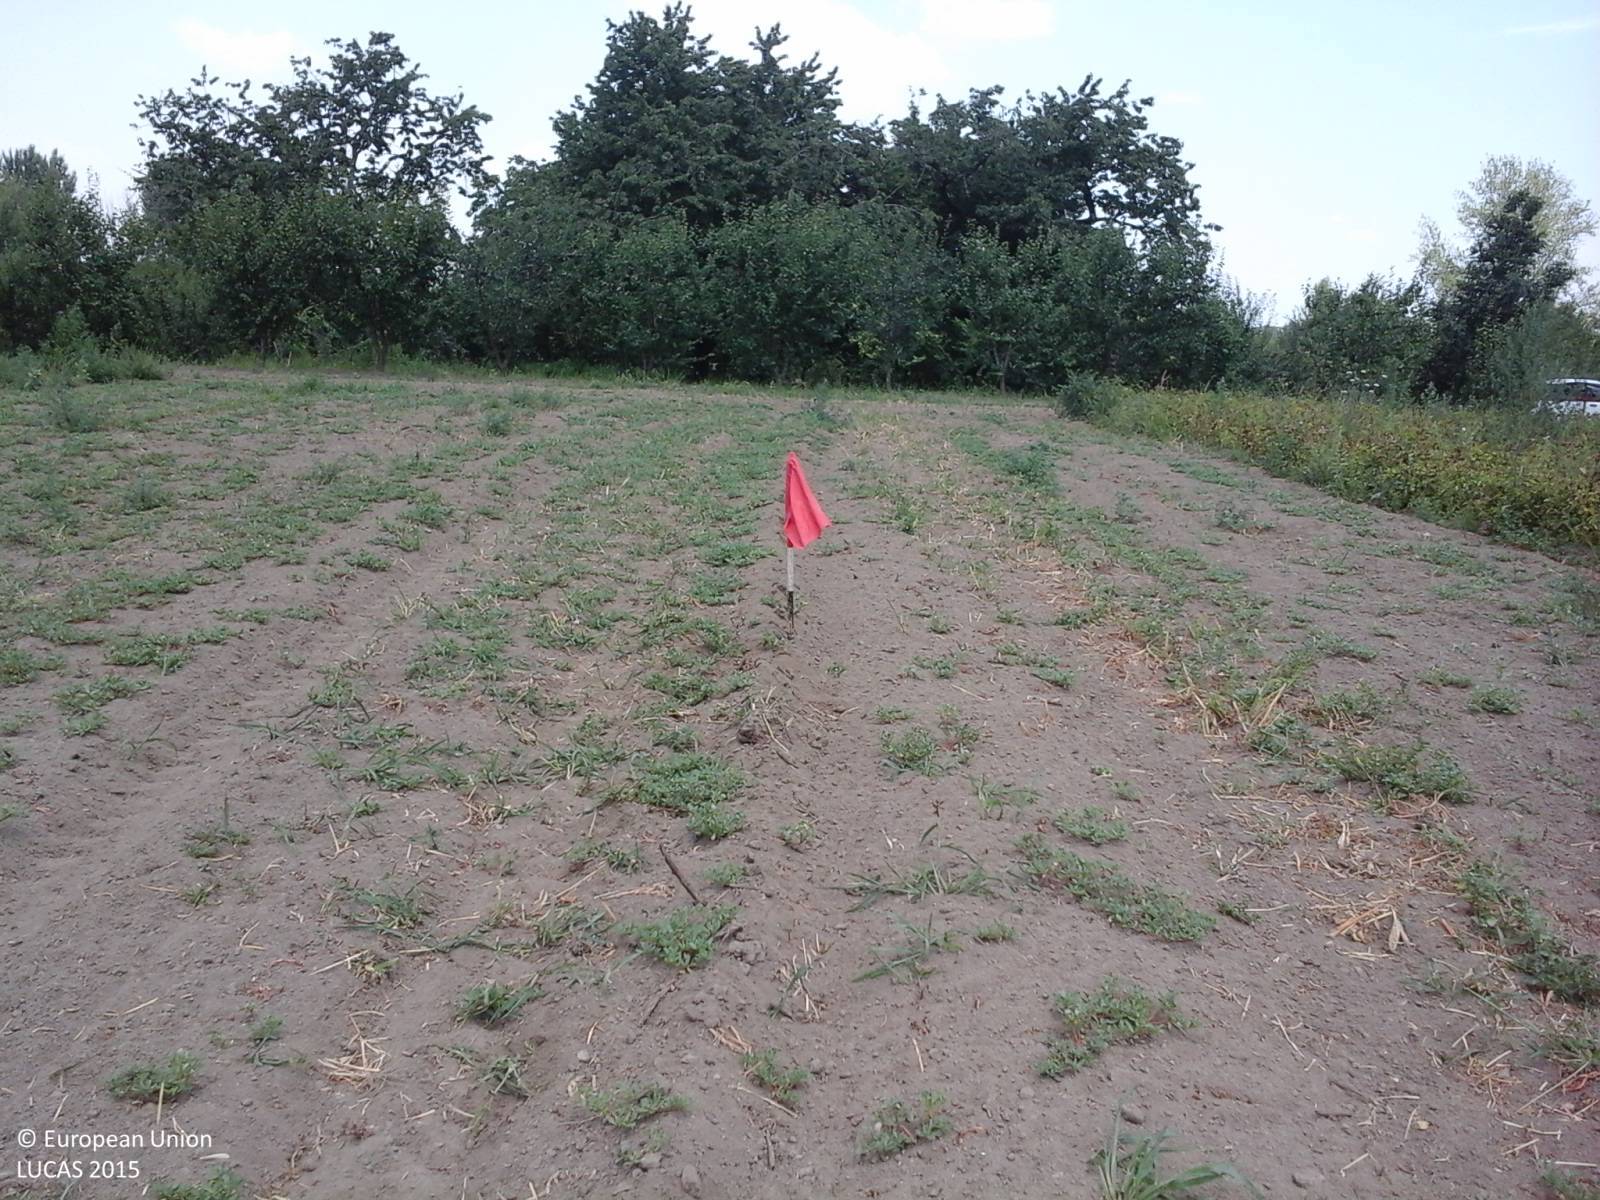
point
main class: Grassland
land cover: Spontaneously vegetated surfaces
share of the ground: < 10 %
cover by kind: herbaceous plants 100 %
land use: Agriculture (excluding fallow land and kitchen gardens)
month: July
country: IT
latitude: 40.9012
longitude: 14.2204
